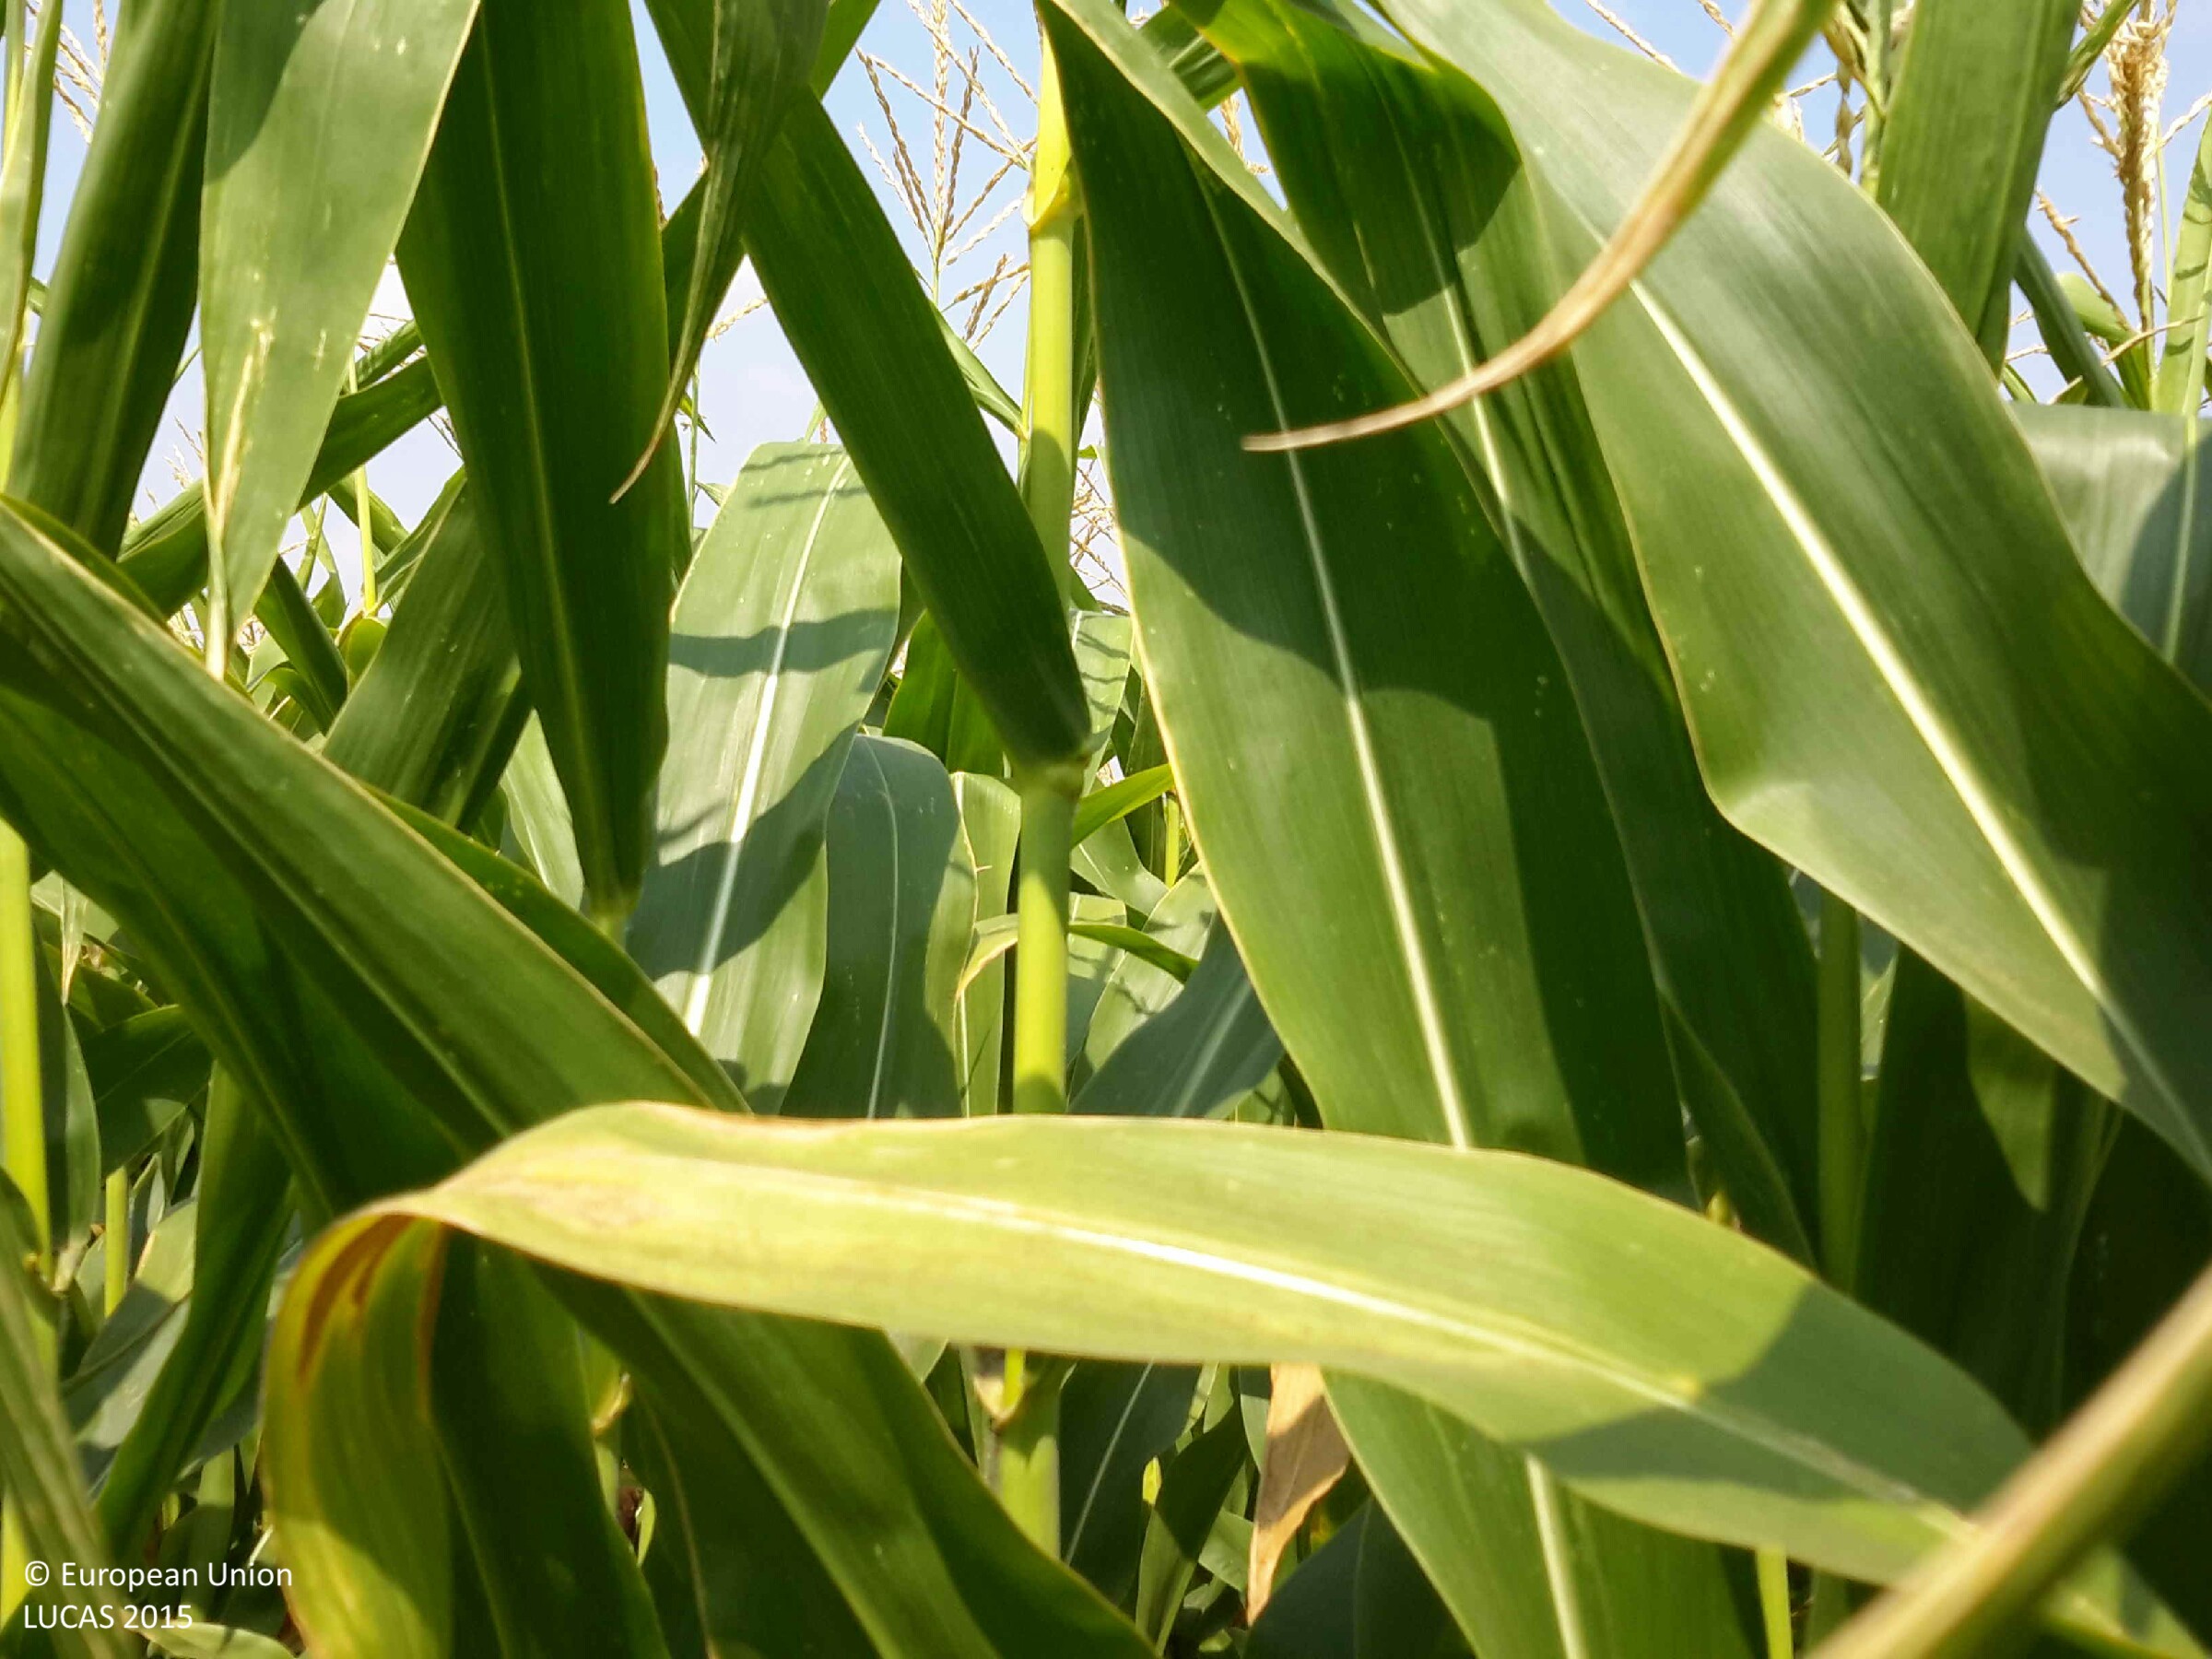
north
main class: Cropland
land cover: Maize
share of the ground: > 75 %
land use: Agriculture (excluding fallow land and kitchen gardens)
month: August
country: HU
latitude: 47.8304
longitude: 17.3960
